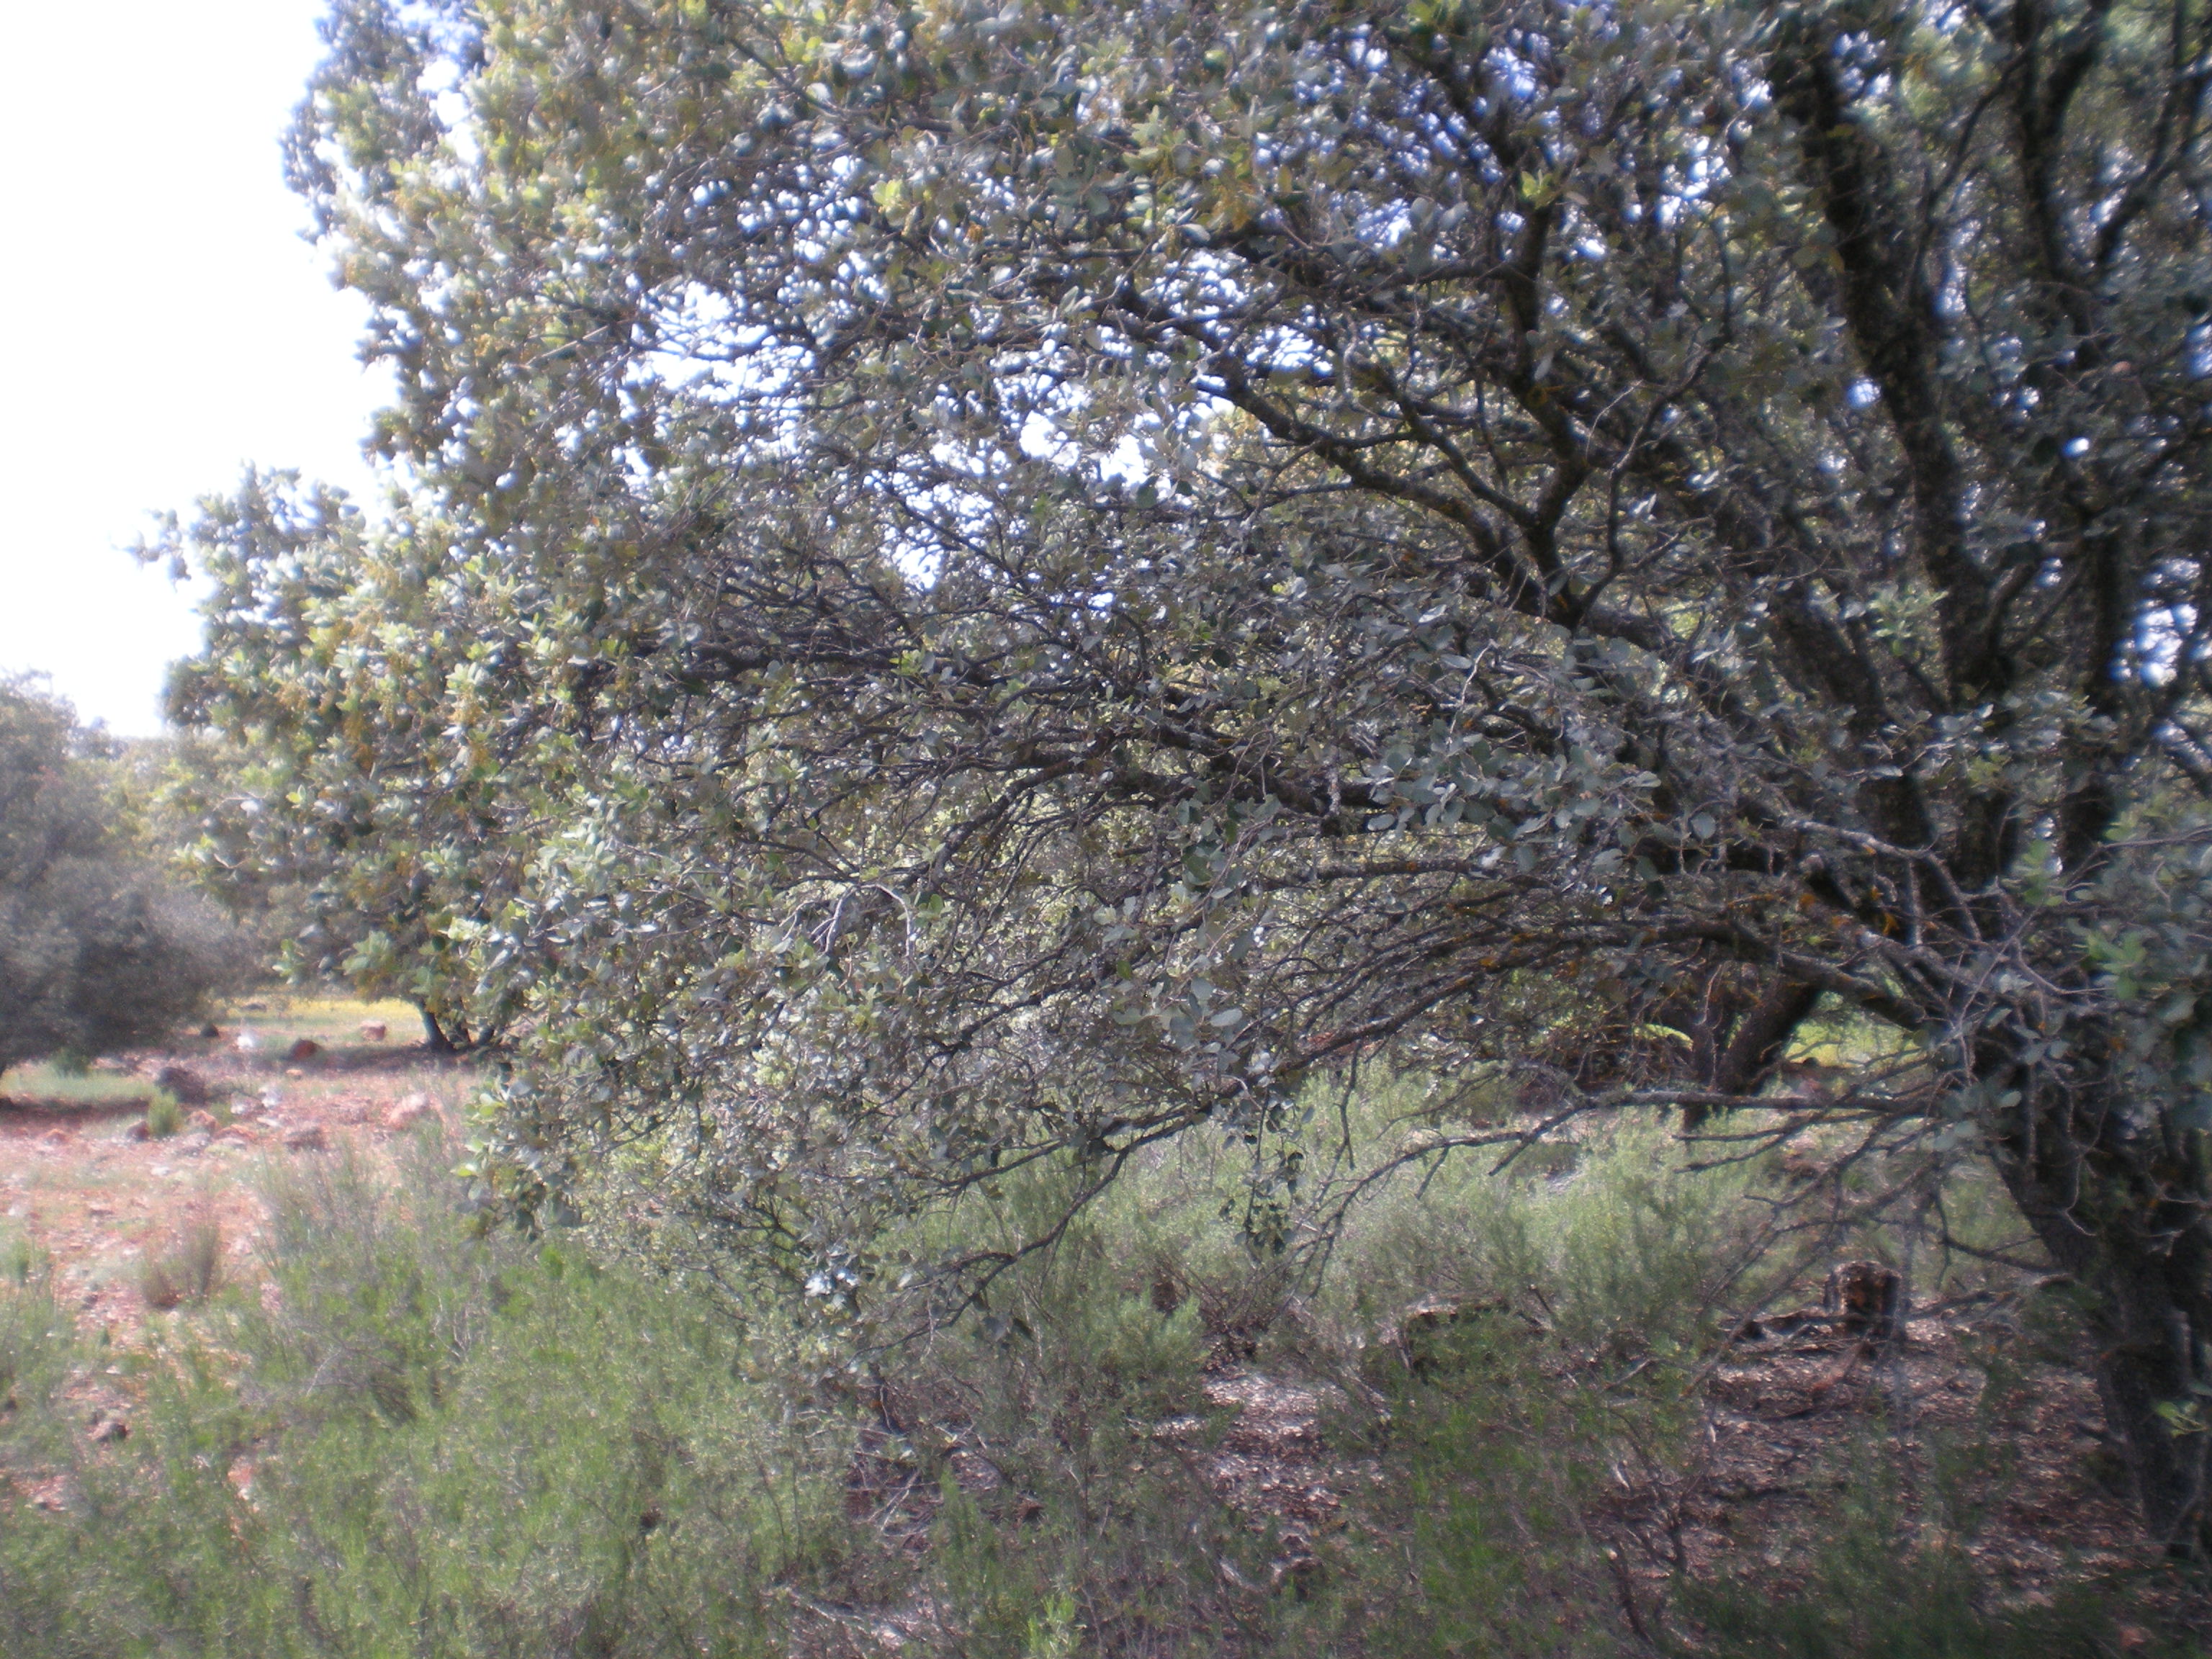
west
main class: Woodland
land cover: Broadleaved woodland
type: broadleaved evergreen forest
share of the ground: 50 - 75 %
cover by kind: broadleaved forest trees 30 %, shrubs 30 %, herbaceous plants 20 %, unconsolidated bare surface 20 %
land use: Other primary production
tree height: < 5 m
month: May
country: ES
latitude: 38.9065
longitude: -2.9818
